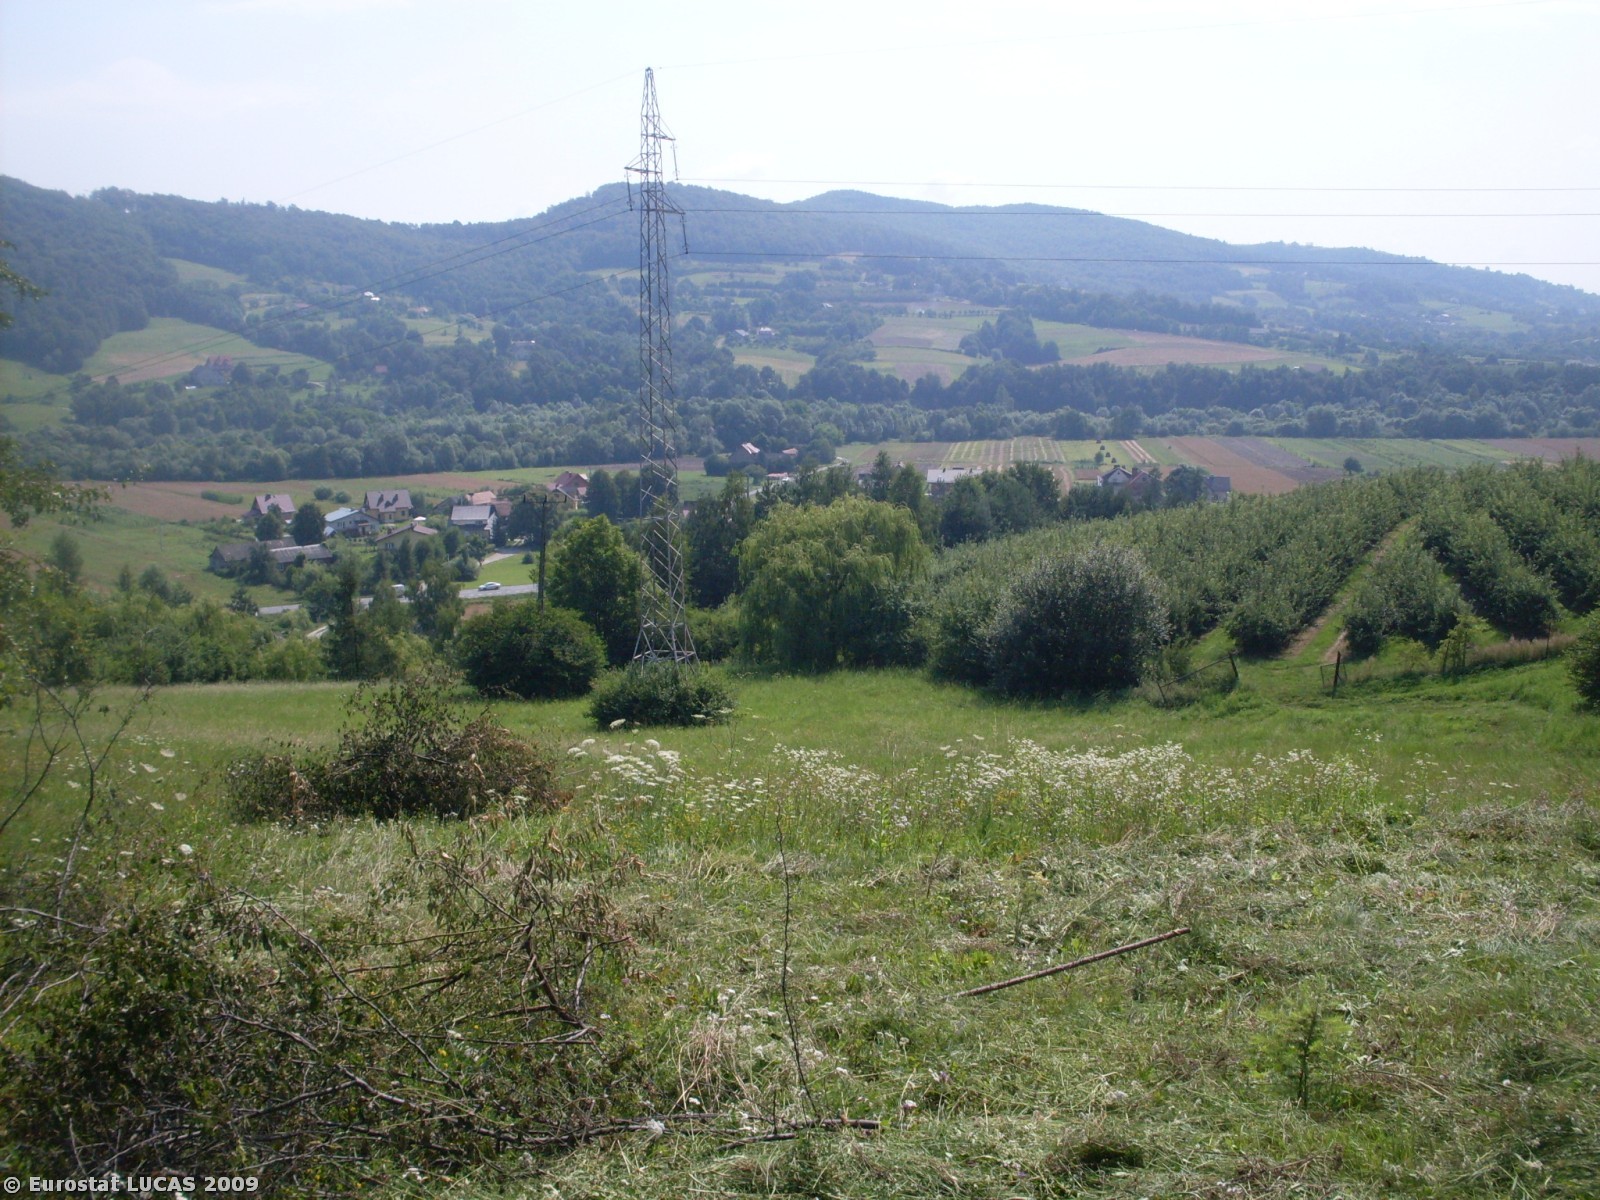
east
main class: Grassland
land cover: Grassland with sparse tree/shrub cover
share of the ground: > 75 %
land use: Agriculture (excluding fallow land and kitchen gardens)
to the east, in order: Grassland with sparse tree/shrub cover; Grassland without tree/shrub cover; Electric lines; Grassland without tree/shrub cover; Abandoned hedges; Grassland with sparse tree/shrub cover; Fences; Grassland with sparse tree/shrub cover; Artificial constructions in urban areas; Grassland with sparse tree/shrub cover; Grassland without tree/shrub cover; Electric lines; Grassland with sparse tree/shrub cover
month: July
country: PL
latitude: 49.7583
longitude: 20.6303
